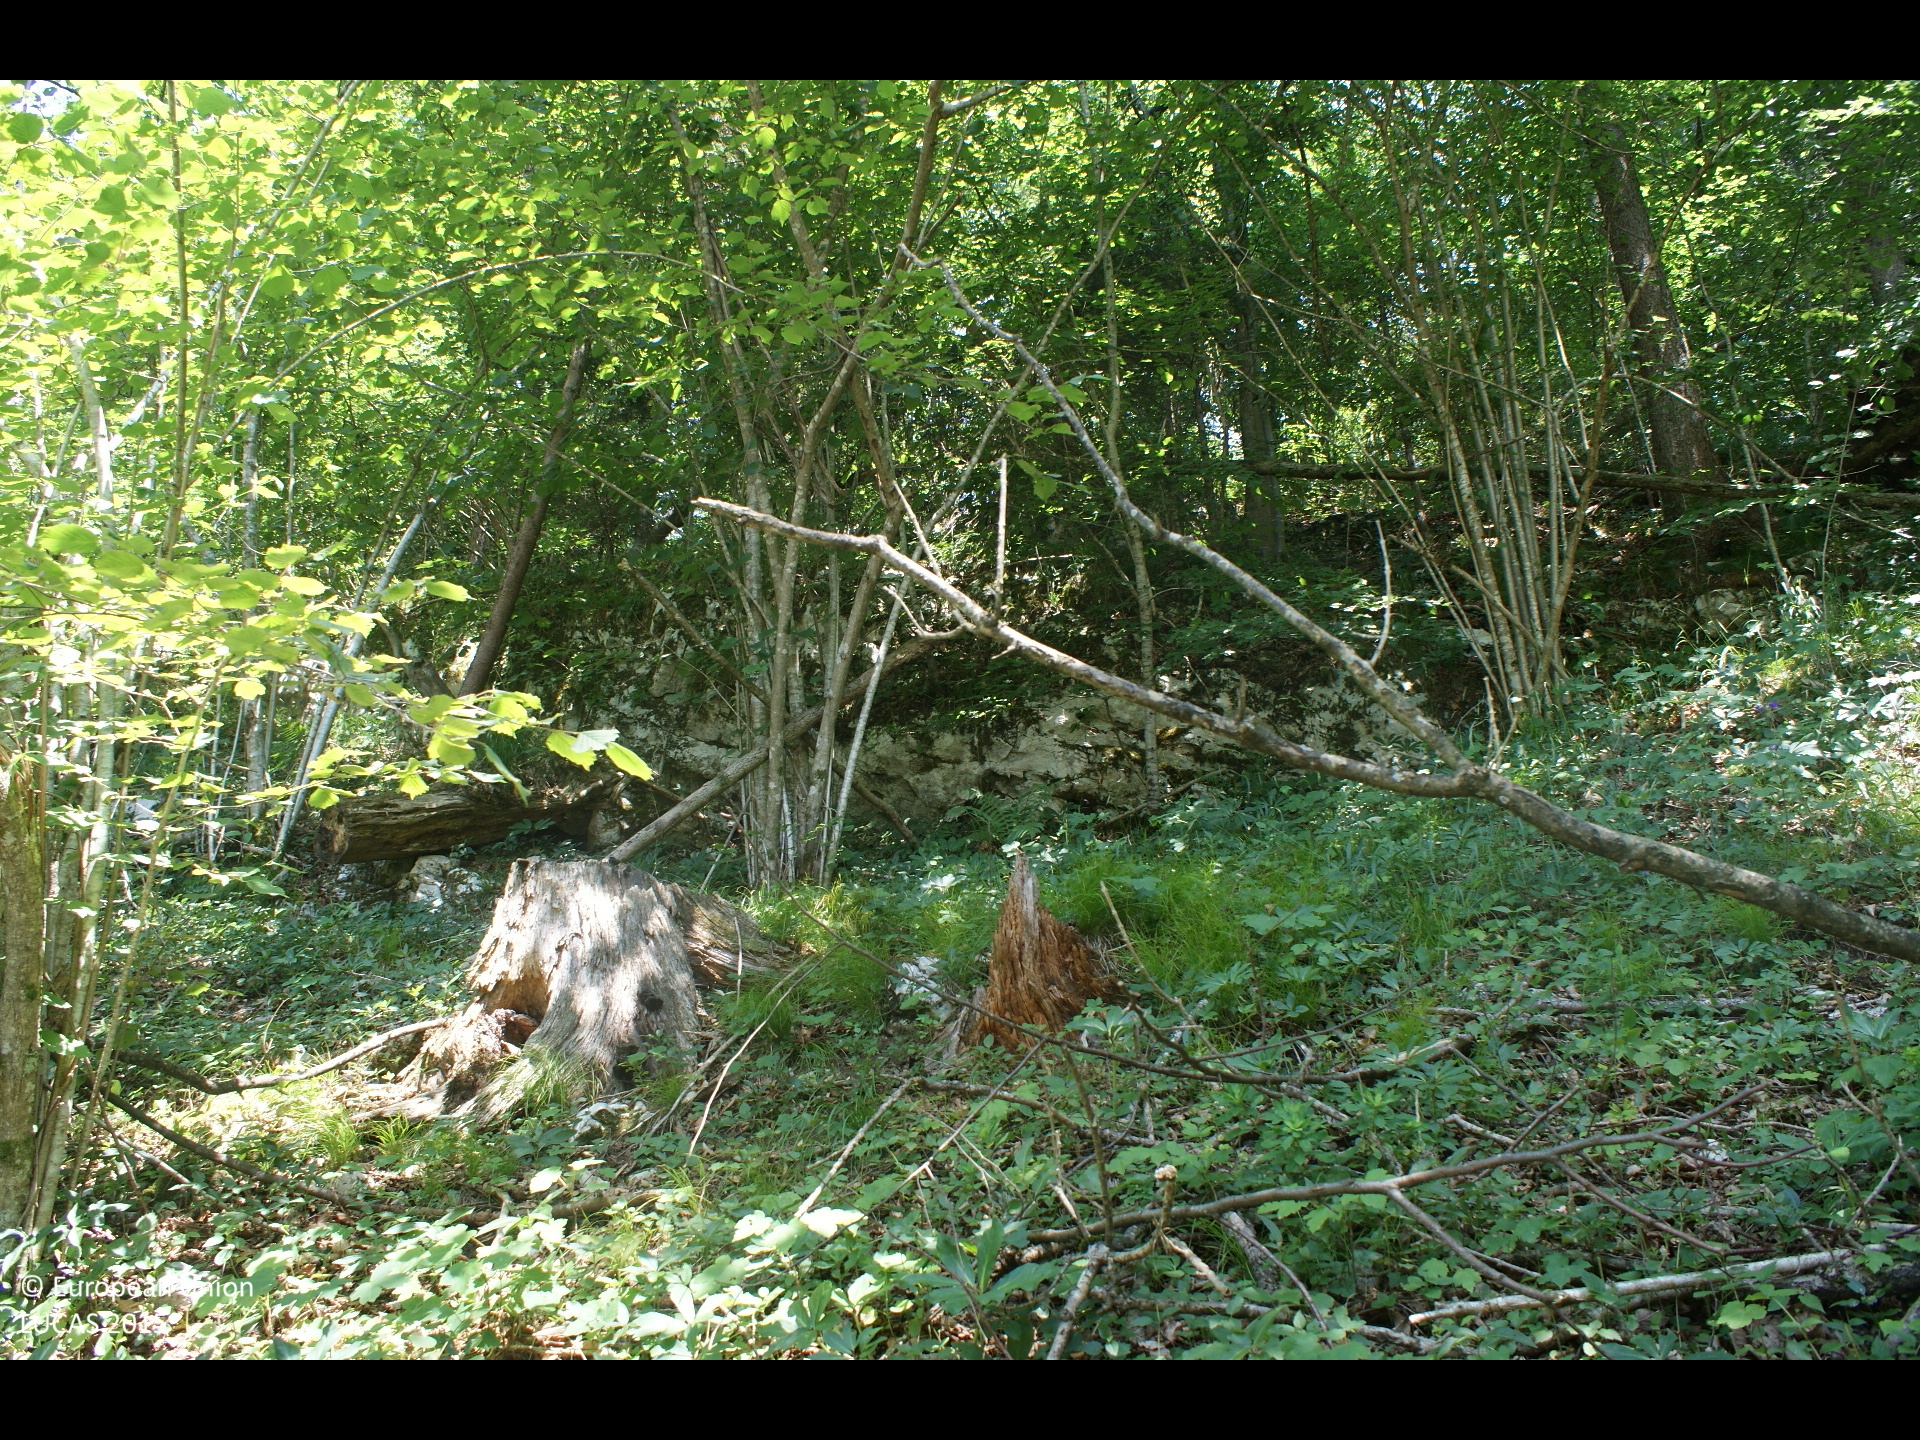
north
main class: Woodland
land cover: Other mixed woodland
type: mesophytic deciduous forest
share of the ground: > 75 %
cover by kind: broadleaved forest trees 50 %, coniferous forest trees 30 %, shrubs 20 %
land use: Forestry
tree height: > 5 m
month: July
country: AT
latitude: 47.9077
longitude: 14.2406
